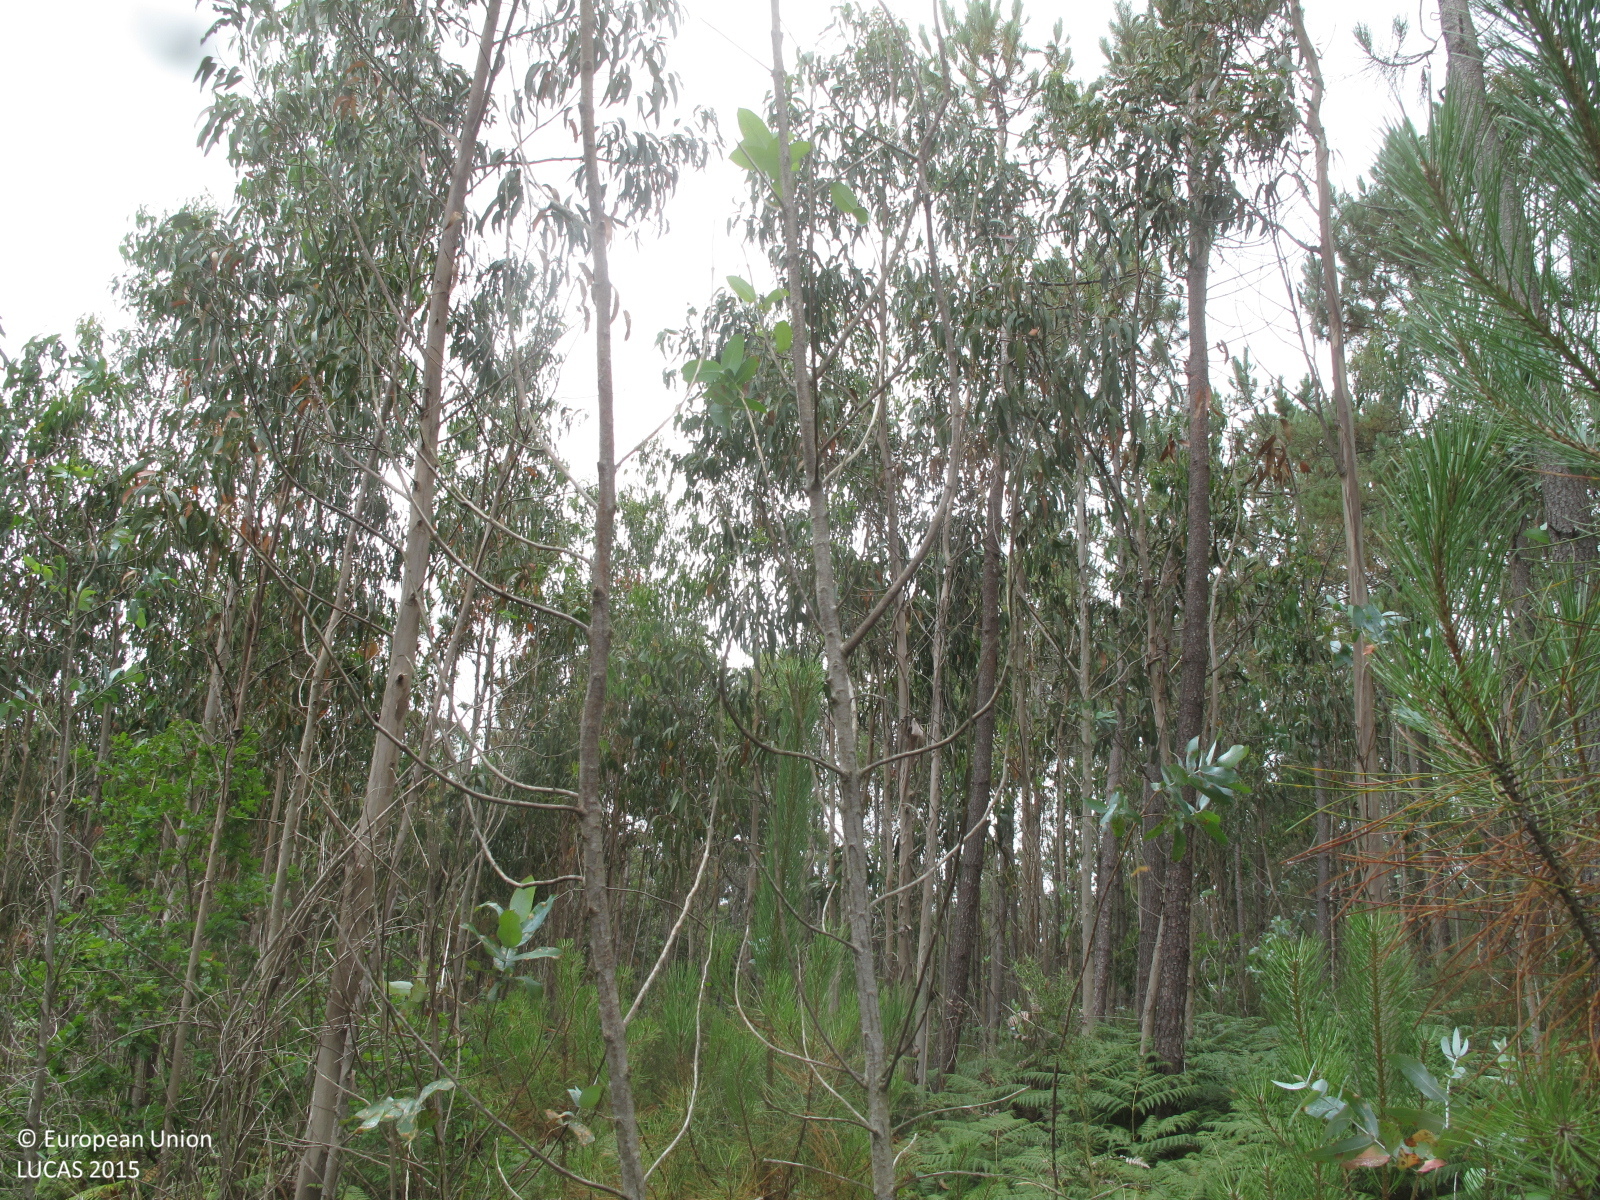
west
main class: Woodland
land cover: Broadleaved woodland
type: exotic forest
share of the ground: 25 - 50 %
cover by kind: broadleaved forest trees 45 %, herbaceous plants 30 %, shrubs 20 %, coniferous forest trees 5 %
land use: Forestry
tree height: > 5 m
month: July
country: ES
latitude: 43.0161
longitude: -9.2081
